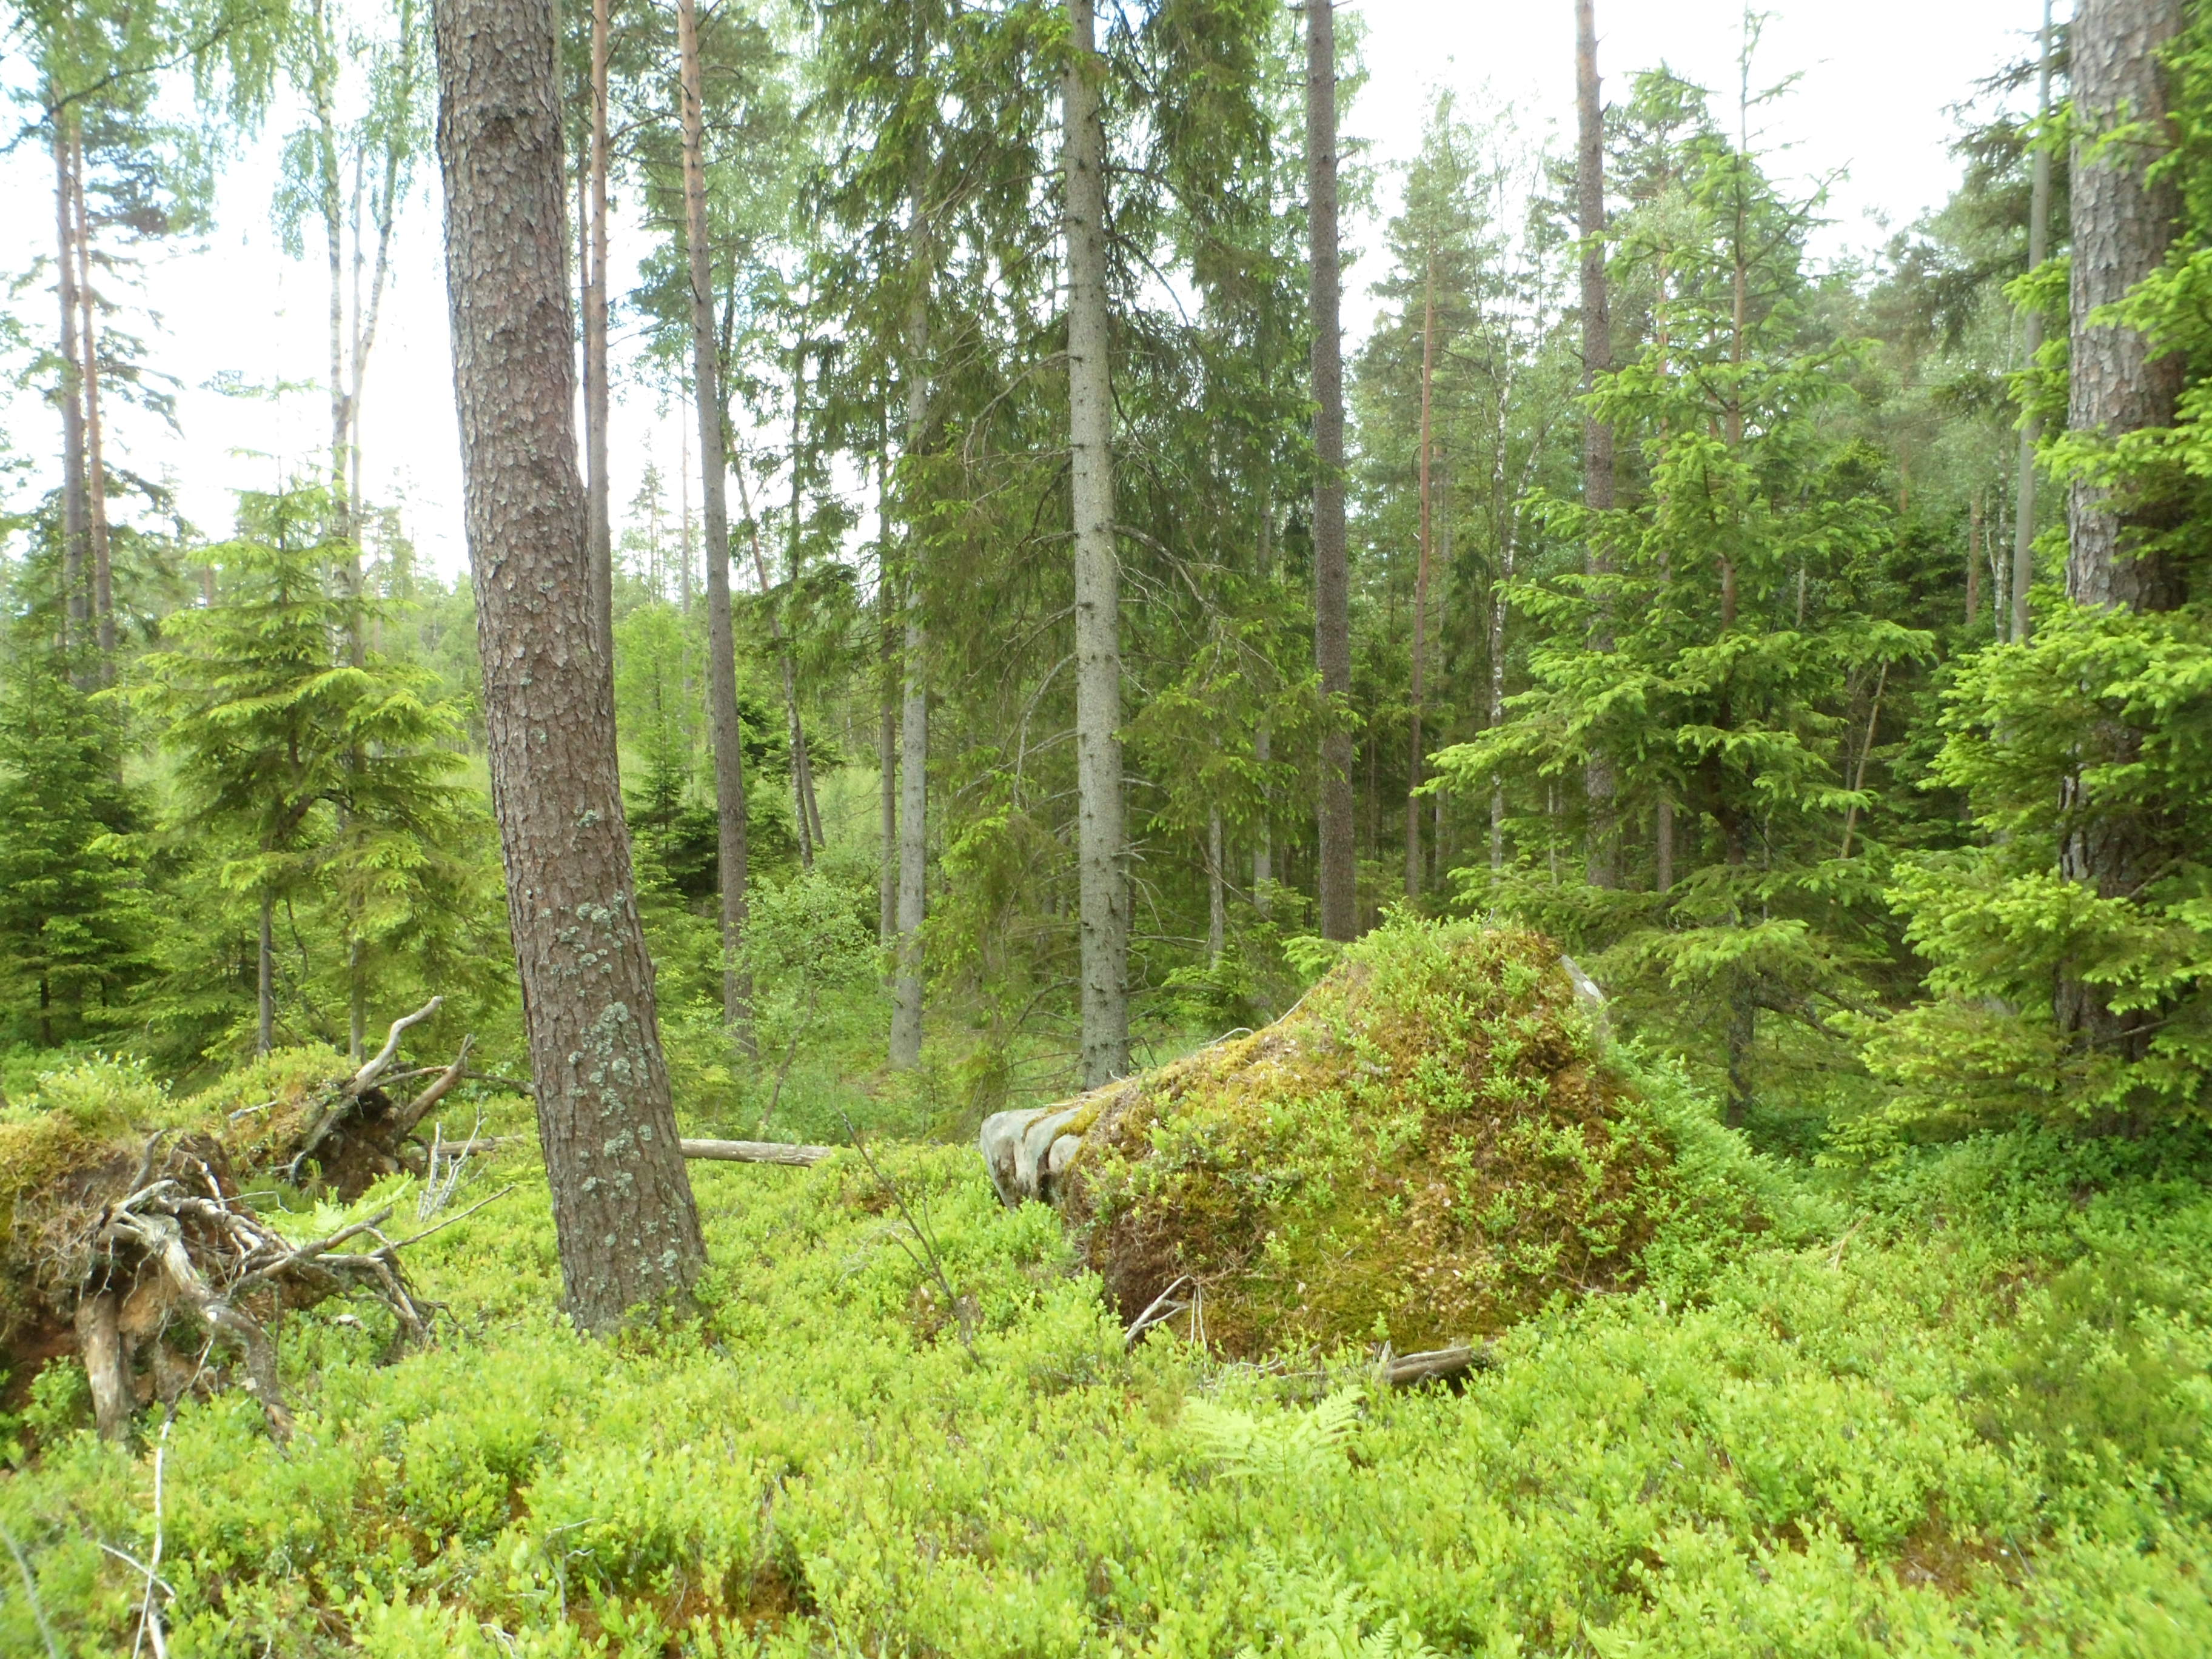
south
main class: Woodland
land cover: Pine dominated coniferous woodland
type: boreal forest
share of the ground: 25 - 50 %
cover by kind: shrubs 40 %, coniferous forest trees 30 %, lichens and mosses 20 %, broadleaved forest trees 5 %, herbaceous plants 5 %
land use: Forestry
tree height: > 5 m
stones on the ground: > 50 %
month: June
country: SE
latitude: 56.9255
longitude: 14.3177
